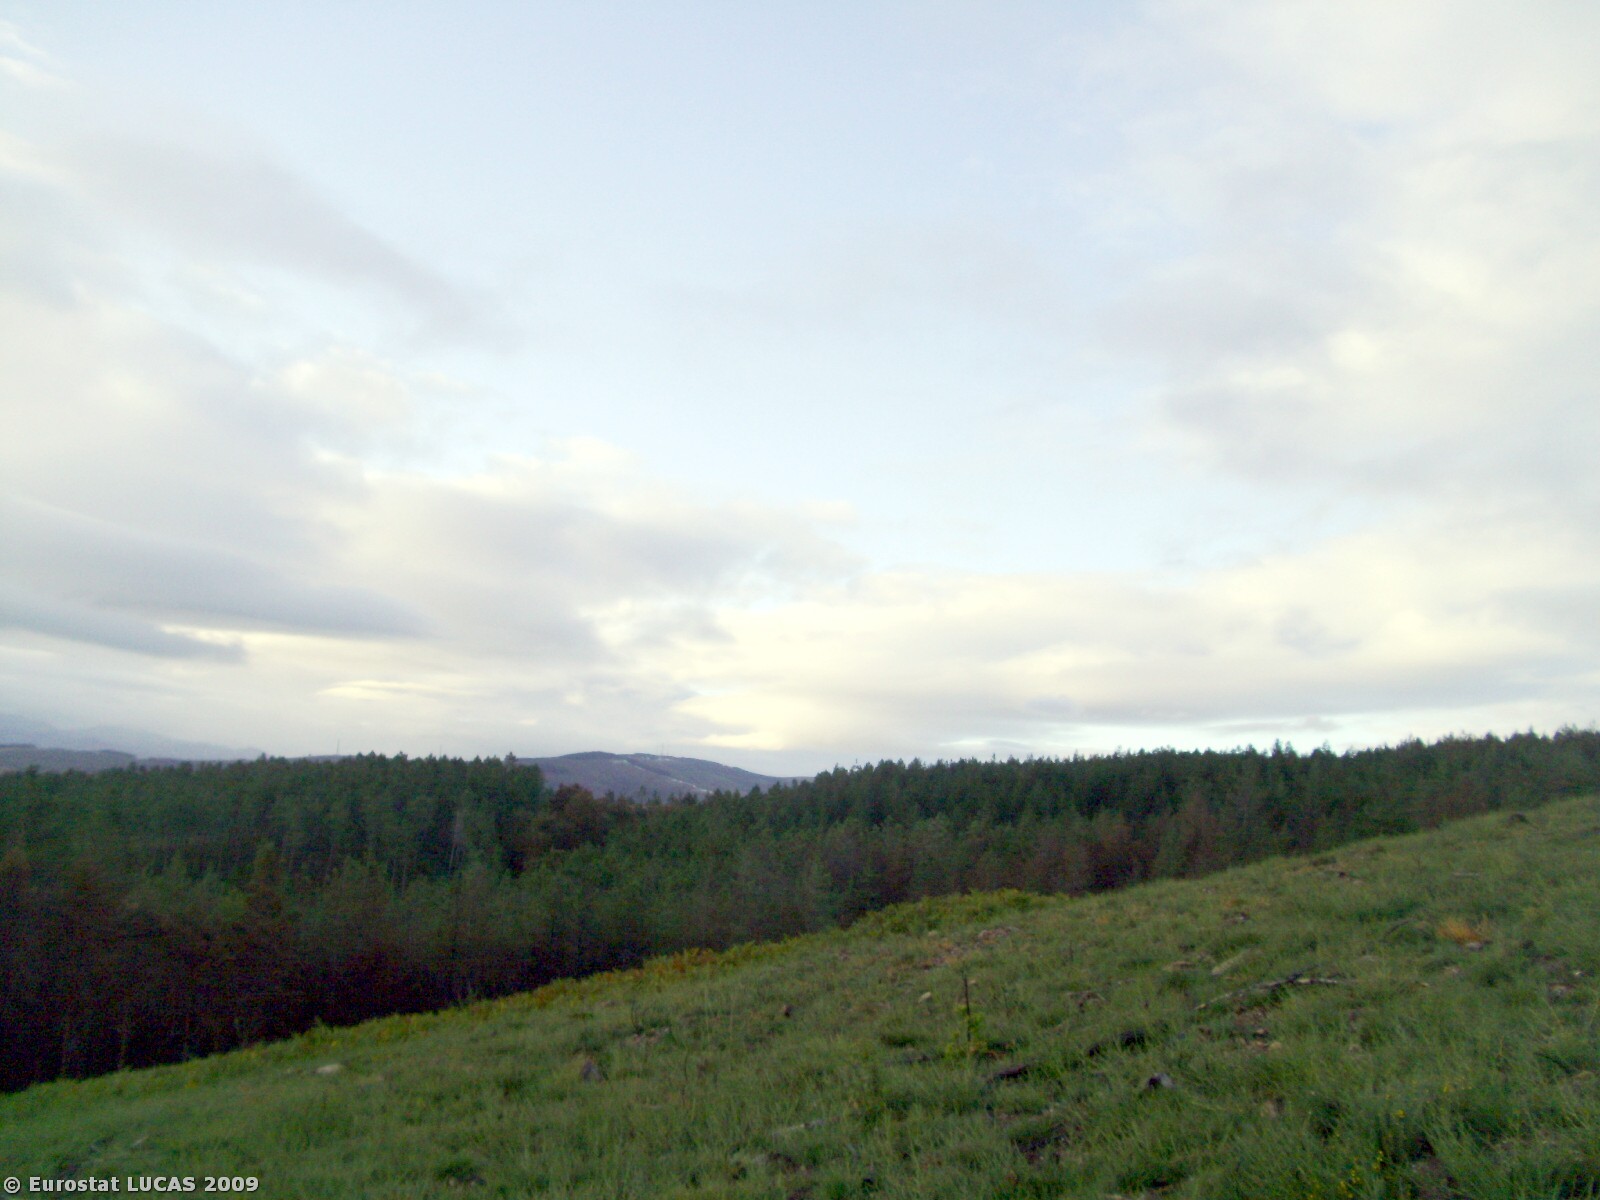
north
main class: Shrubland
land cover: Shrubland without tree cover
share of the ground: > 75 %
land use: Unused
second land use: Energy production
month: September
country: PT
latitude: 41.6838
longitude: -7.9339
